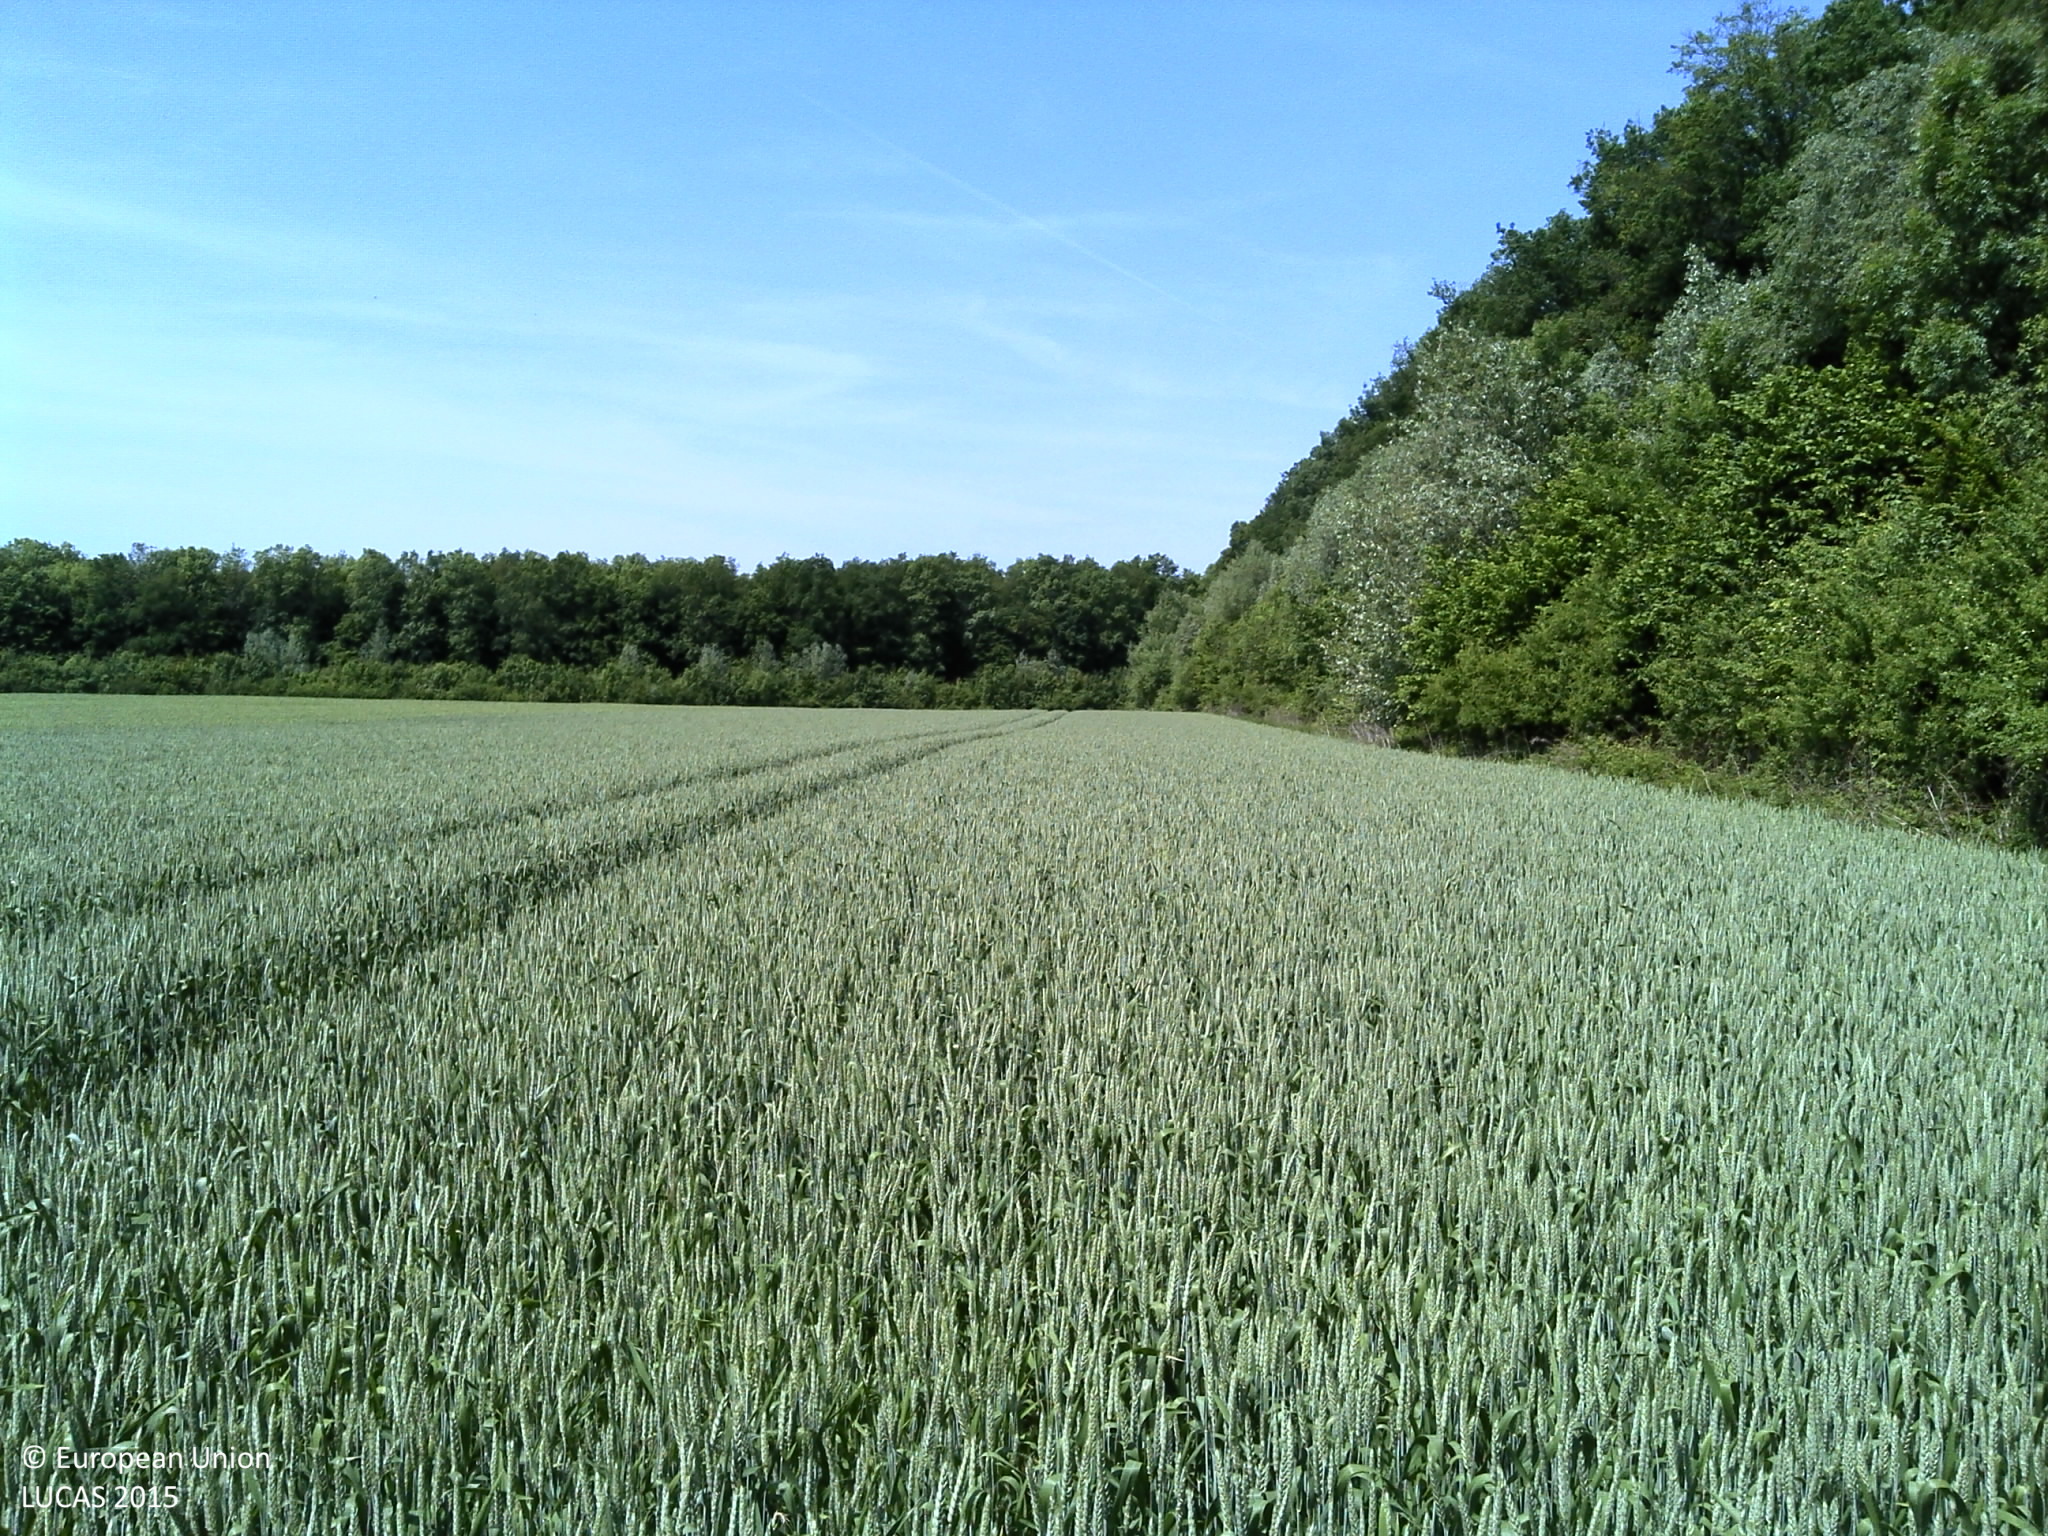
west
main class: Cropland
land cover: Common wheat
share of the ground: > 75 %
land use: Agriculture (excluding fallow land and kitchen gardens)
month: May
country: HR
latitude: 45.5102
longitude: 18.2096
